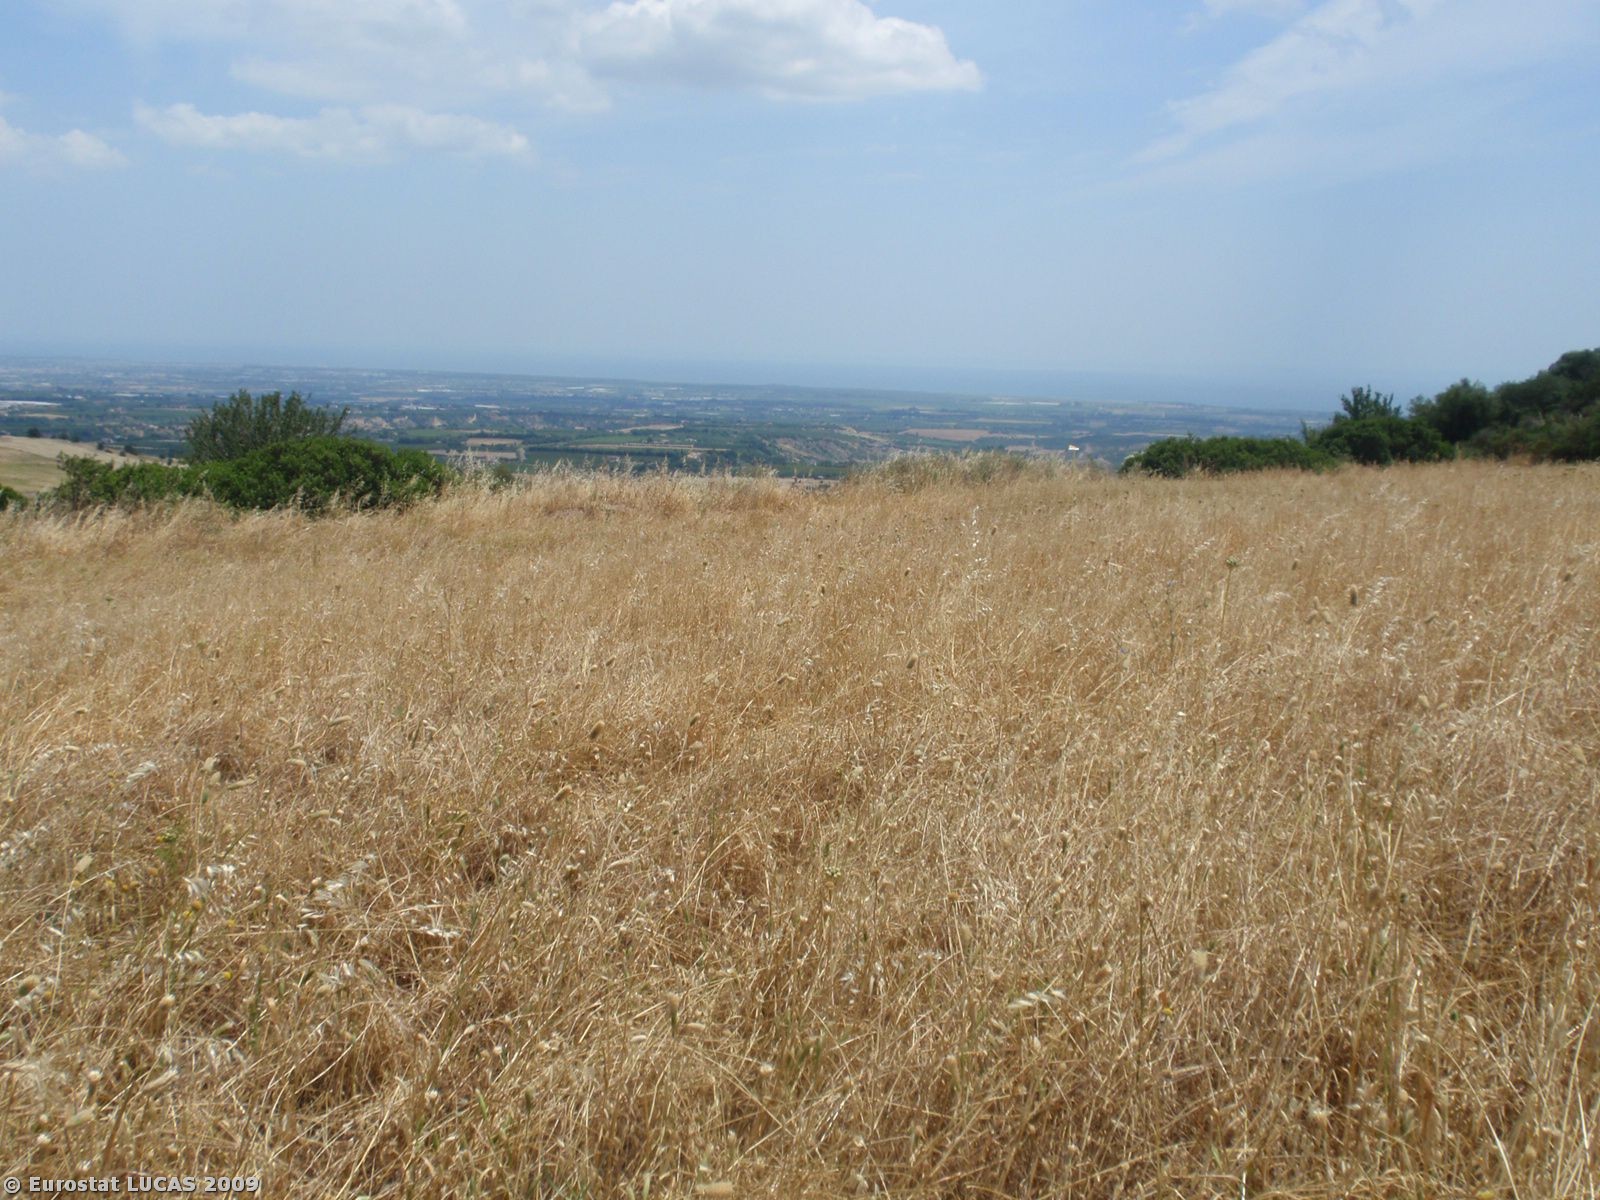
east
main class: Cropland
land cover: Mixed cereals for fodder
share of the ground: > 75 %
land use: Agriculture (excluding fallow land and kitchen gardens)
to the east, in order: Mixed cereals for fodder; Grass margins; Tracks; Grass margins; Mixed cereals for fodder; Shrubland with sparse tree cover; Mixed cereals for fodder
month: June
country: IT
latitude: 40.1581
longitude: 16.5369
